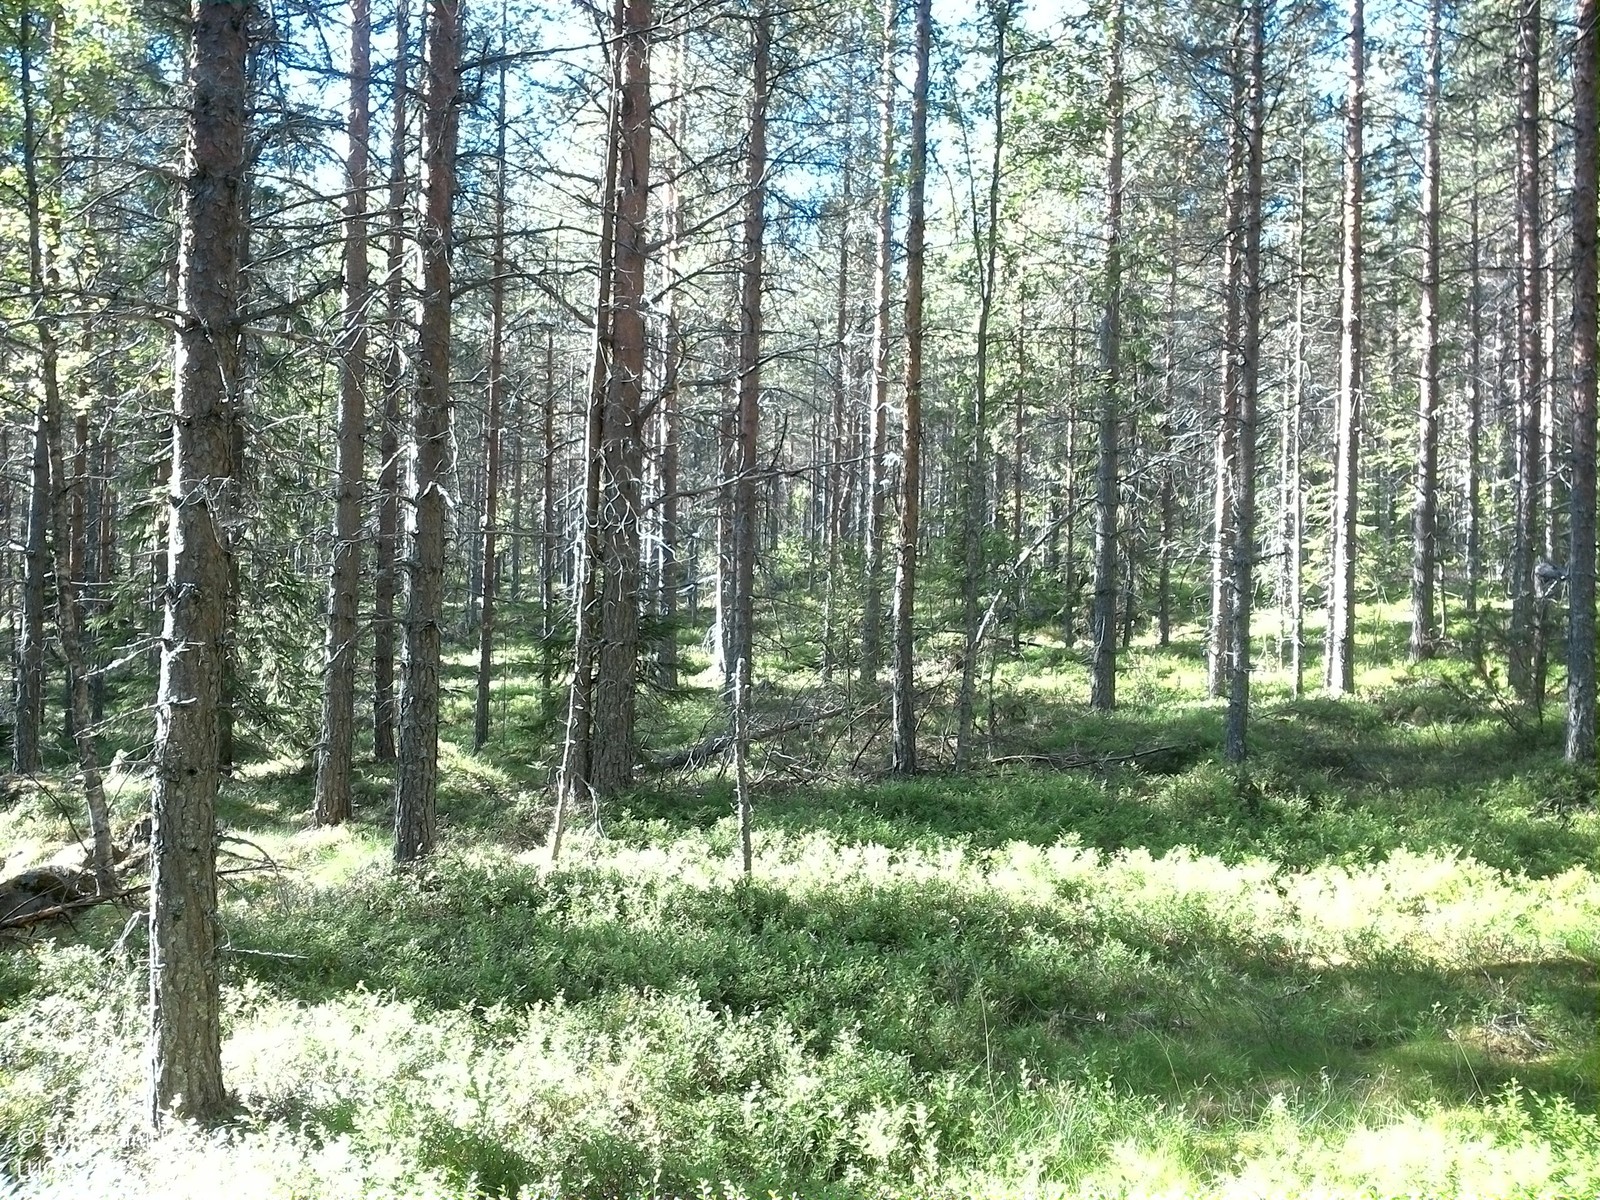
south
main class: Woodland
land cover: Pine dominated coniferous woodland
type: boreal forest
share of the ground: > 75 %
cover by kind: coniferous forest trees 75 %, shrubs 25 %
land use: Forestry
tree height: > 5 m
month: August
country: SE
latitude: 63.6601
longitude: 17.8315
